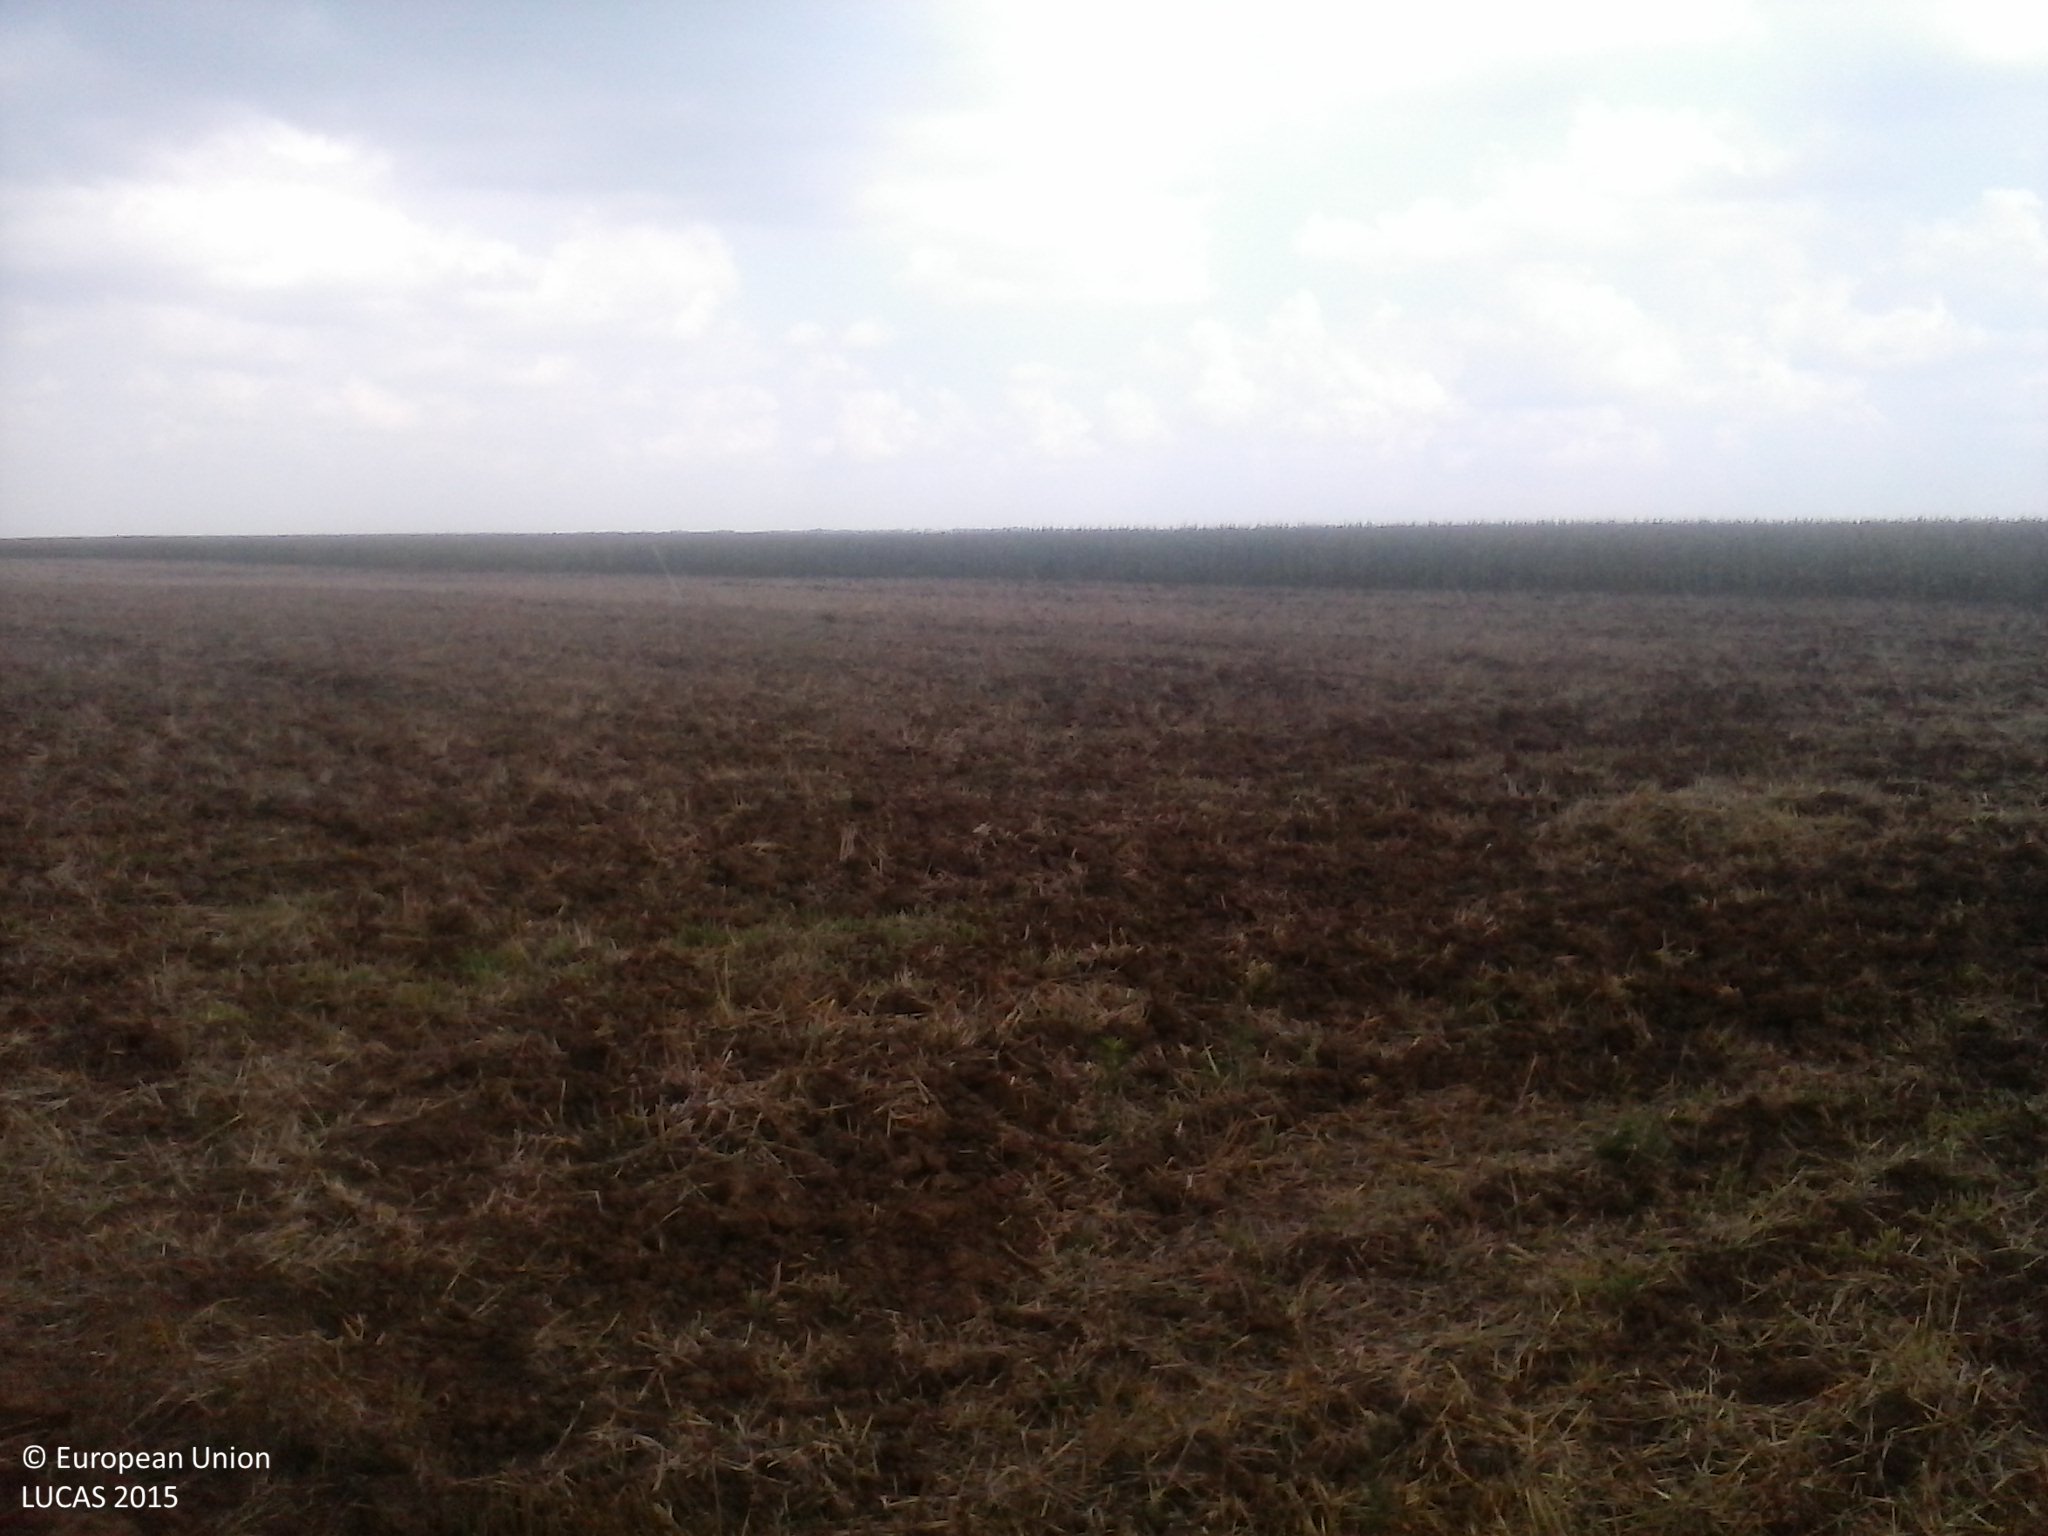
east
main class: Cropland
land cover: Maize
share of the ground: > 75 %
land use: Agriculture (excluding fallow land and kitchen gardens)
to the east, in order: Maize; Common wheat; Maize
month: August
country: HU
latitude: 46.0111
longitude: 18.0520
